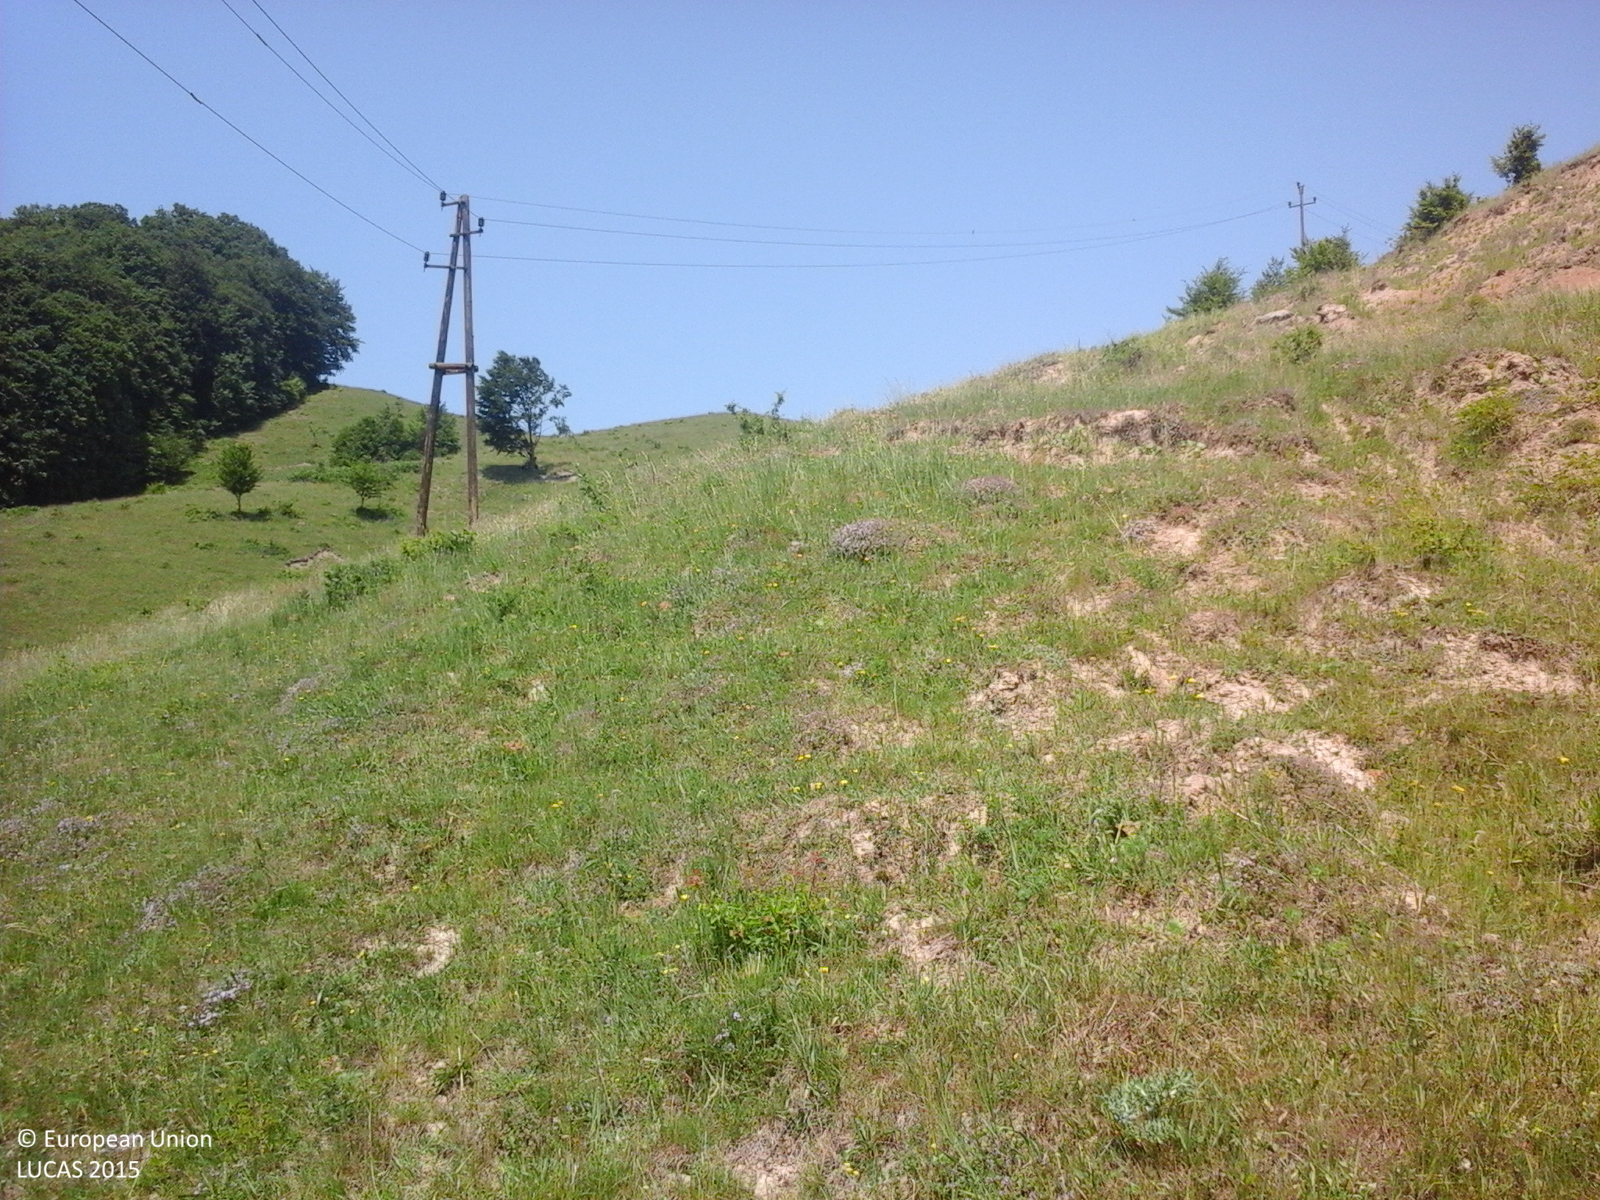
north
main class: Grassland
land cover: Grassland without tree/shrub cover
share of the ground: > 75 %
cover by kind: herbaceous plants 100 %
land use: Agriculture (excluding fallow land and kitchen gardens)
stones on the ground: < 10 %
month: June
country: RO
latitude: 46.6726
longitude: 26.5147
